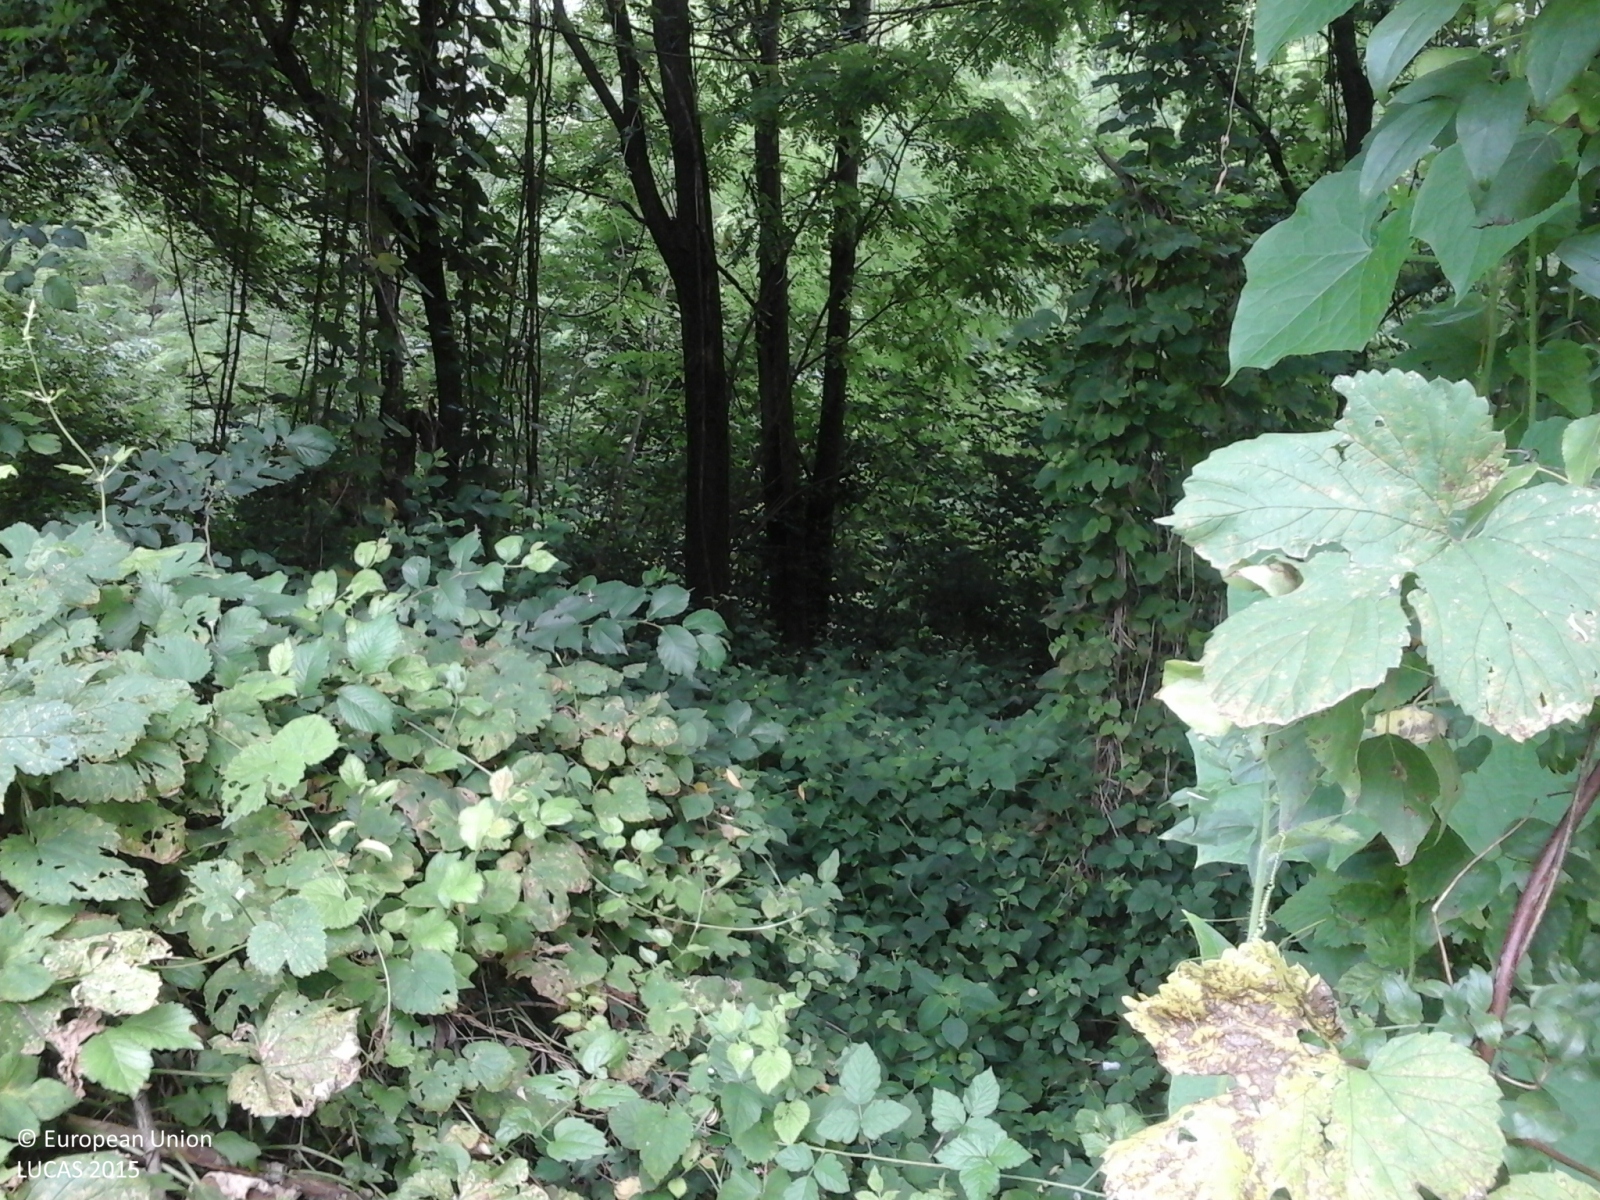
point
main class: Woodland
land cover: Broadleaved woodland
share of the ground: > 75 %
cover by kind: broadleaved forest trees 75 %, shrubs 25 %
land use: Forestry
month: June
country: IT
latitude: 45.9298
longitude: 8.7767
